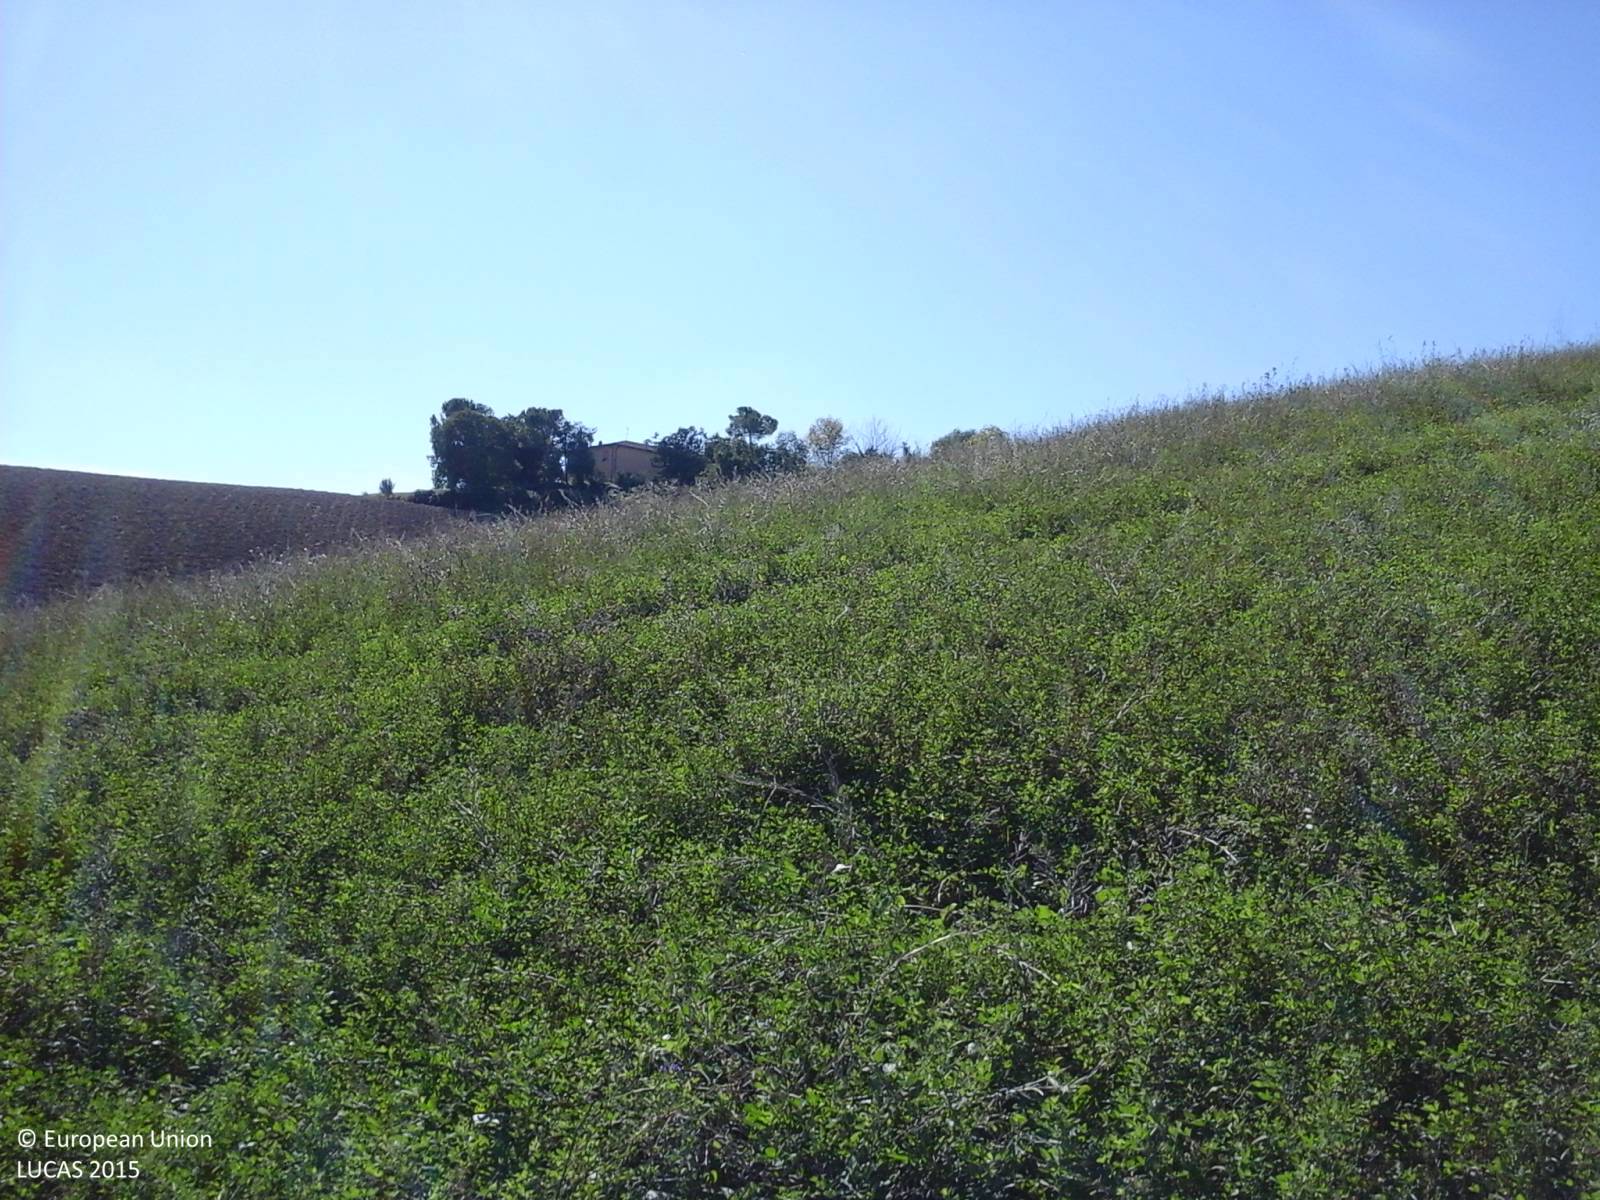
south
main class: Cropland
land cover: Lucerne
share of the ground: > 75 %
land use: Agriculture (excluding fallow land and kitchen gardens)
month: October
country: IT
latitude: 43.5013
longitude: 10.5056
